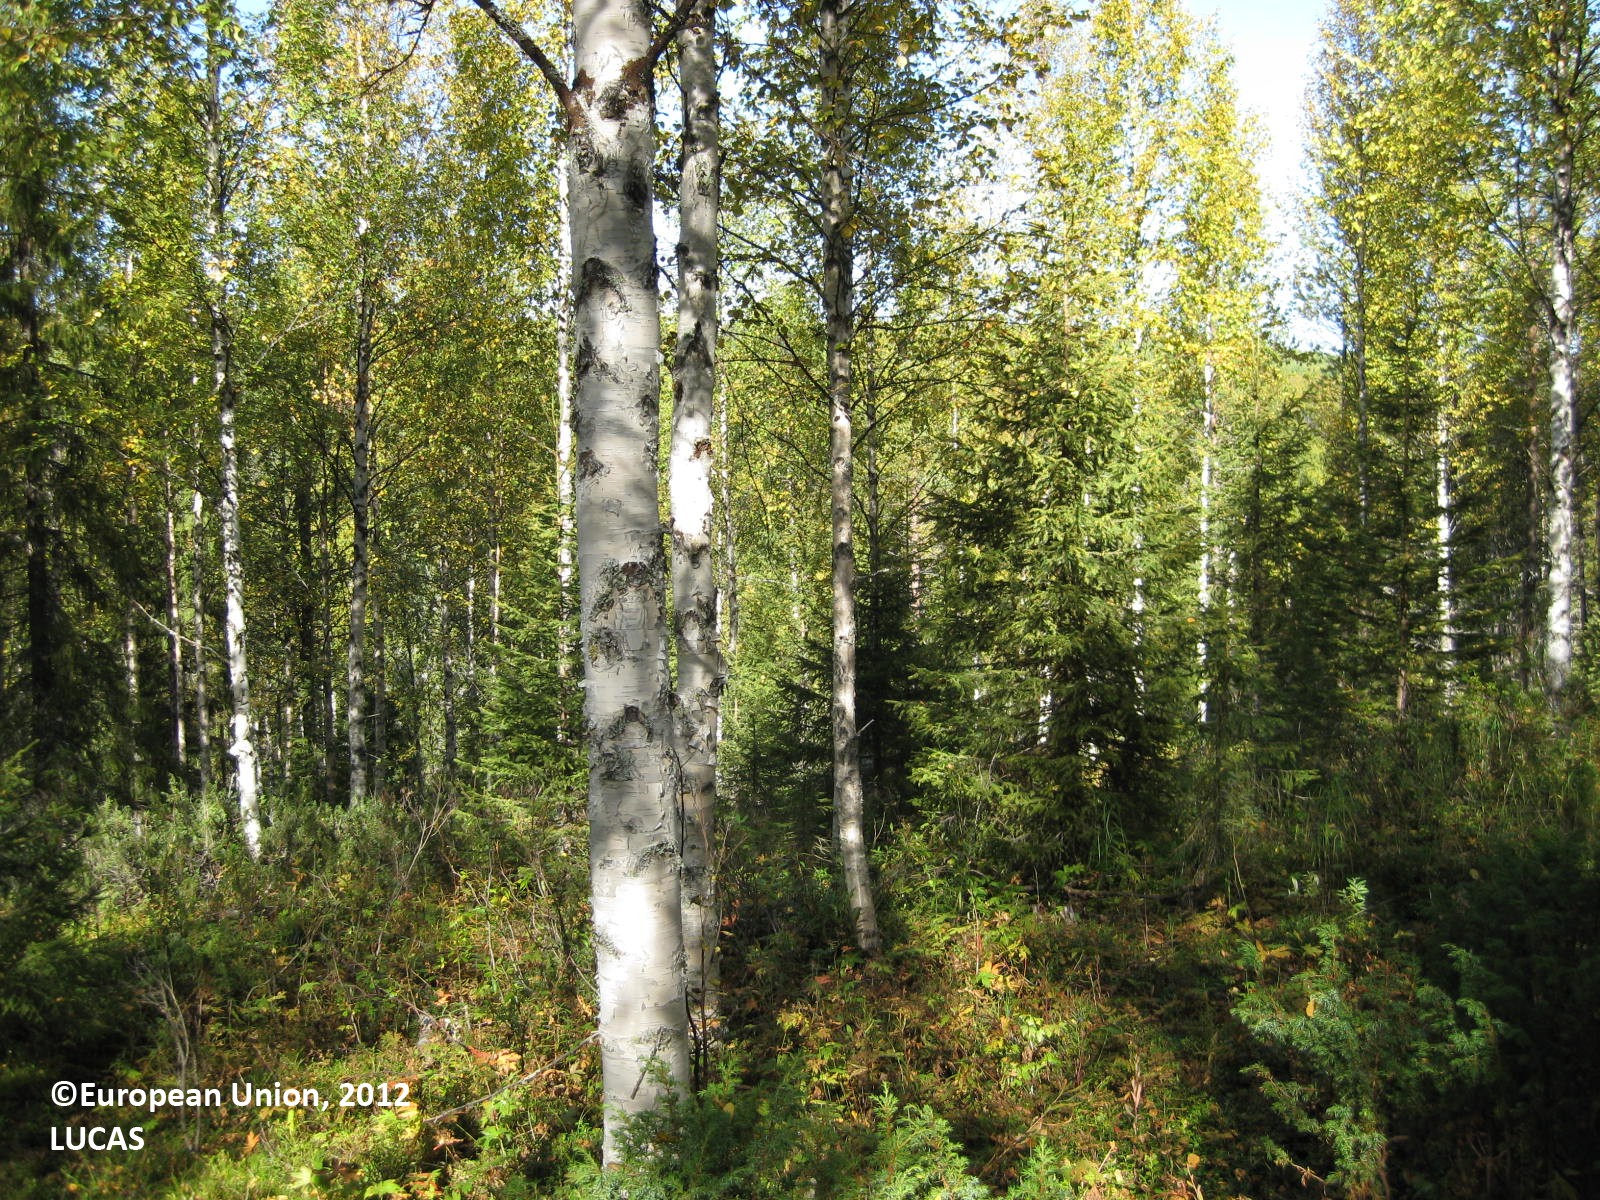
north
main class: Woodland
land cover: Broadleaved woodland
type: boreal forest
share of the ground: 50 - 75 %
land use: Forestry
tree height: > 5 m
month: August
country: FI
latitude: 65.8419
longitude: 28.6204
